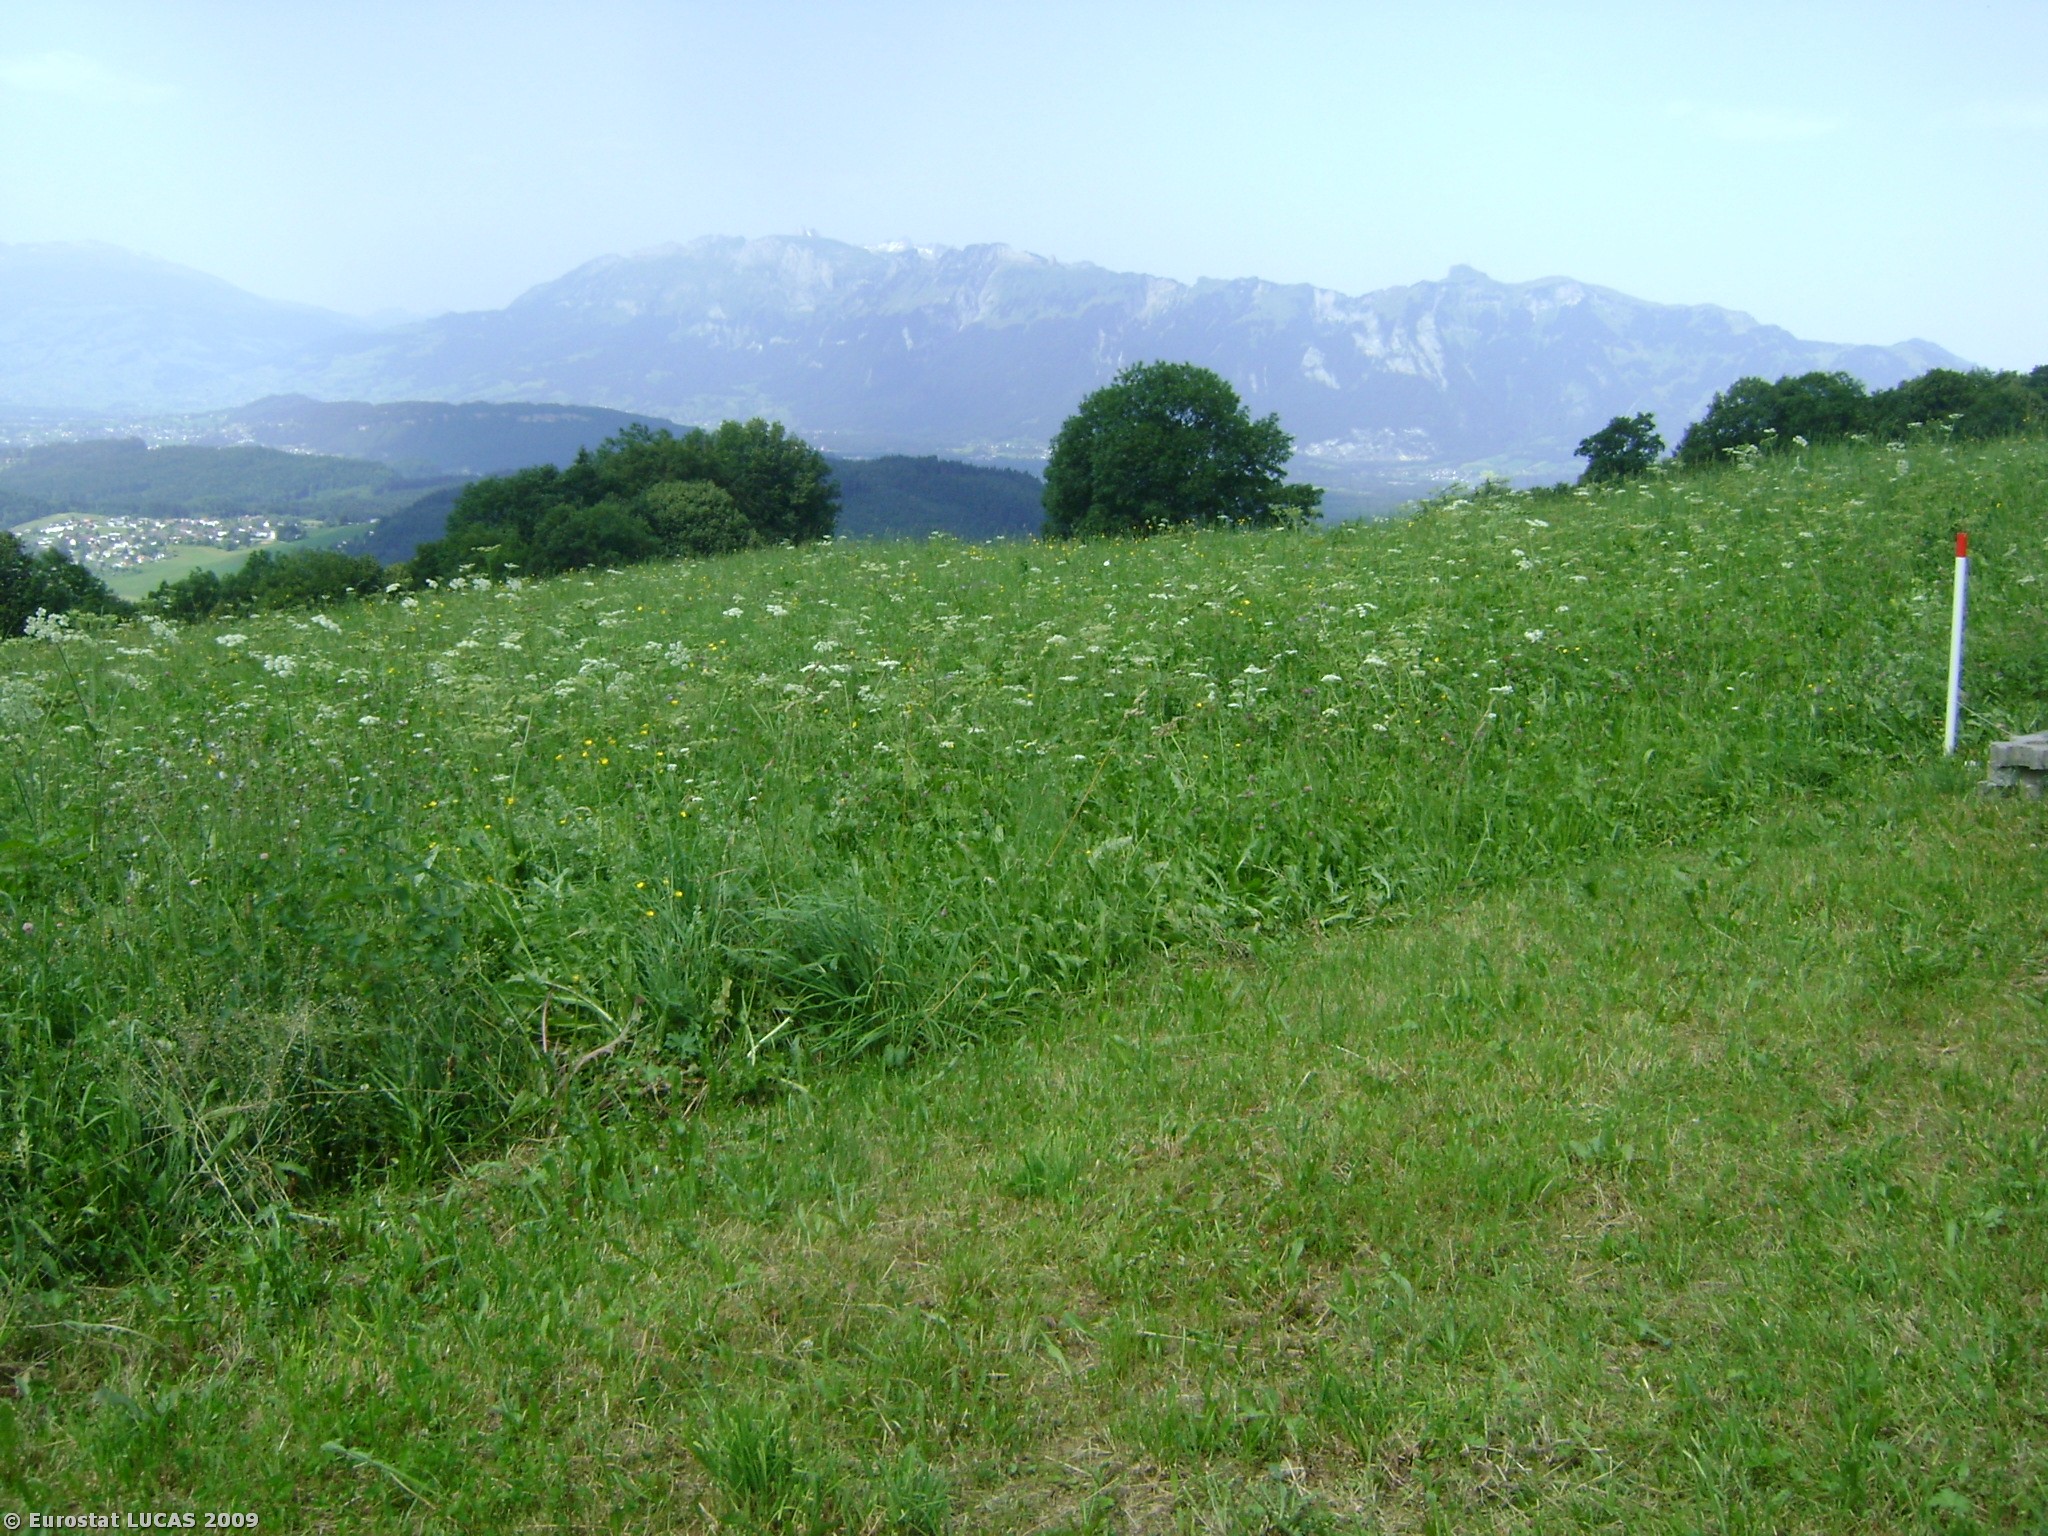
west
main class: Grassland
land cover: Grassland without tree/shrub cover
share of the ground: > 75 %
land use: Agriculture (excluding fallow land and kitchen gardens)
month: July
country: AT
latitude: 47.2511
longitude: 9.6700
